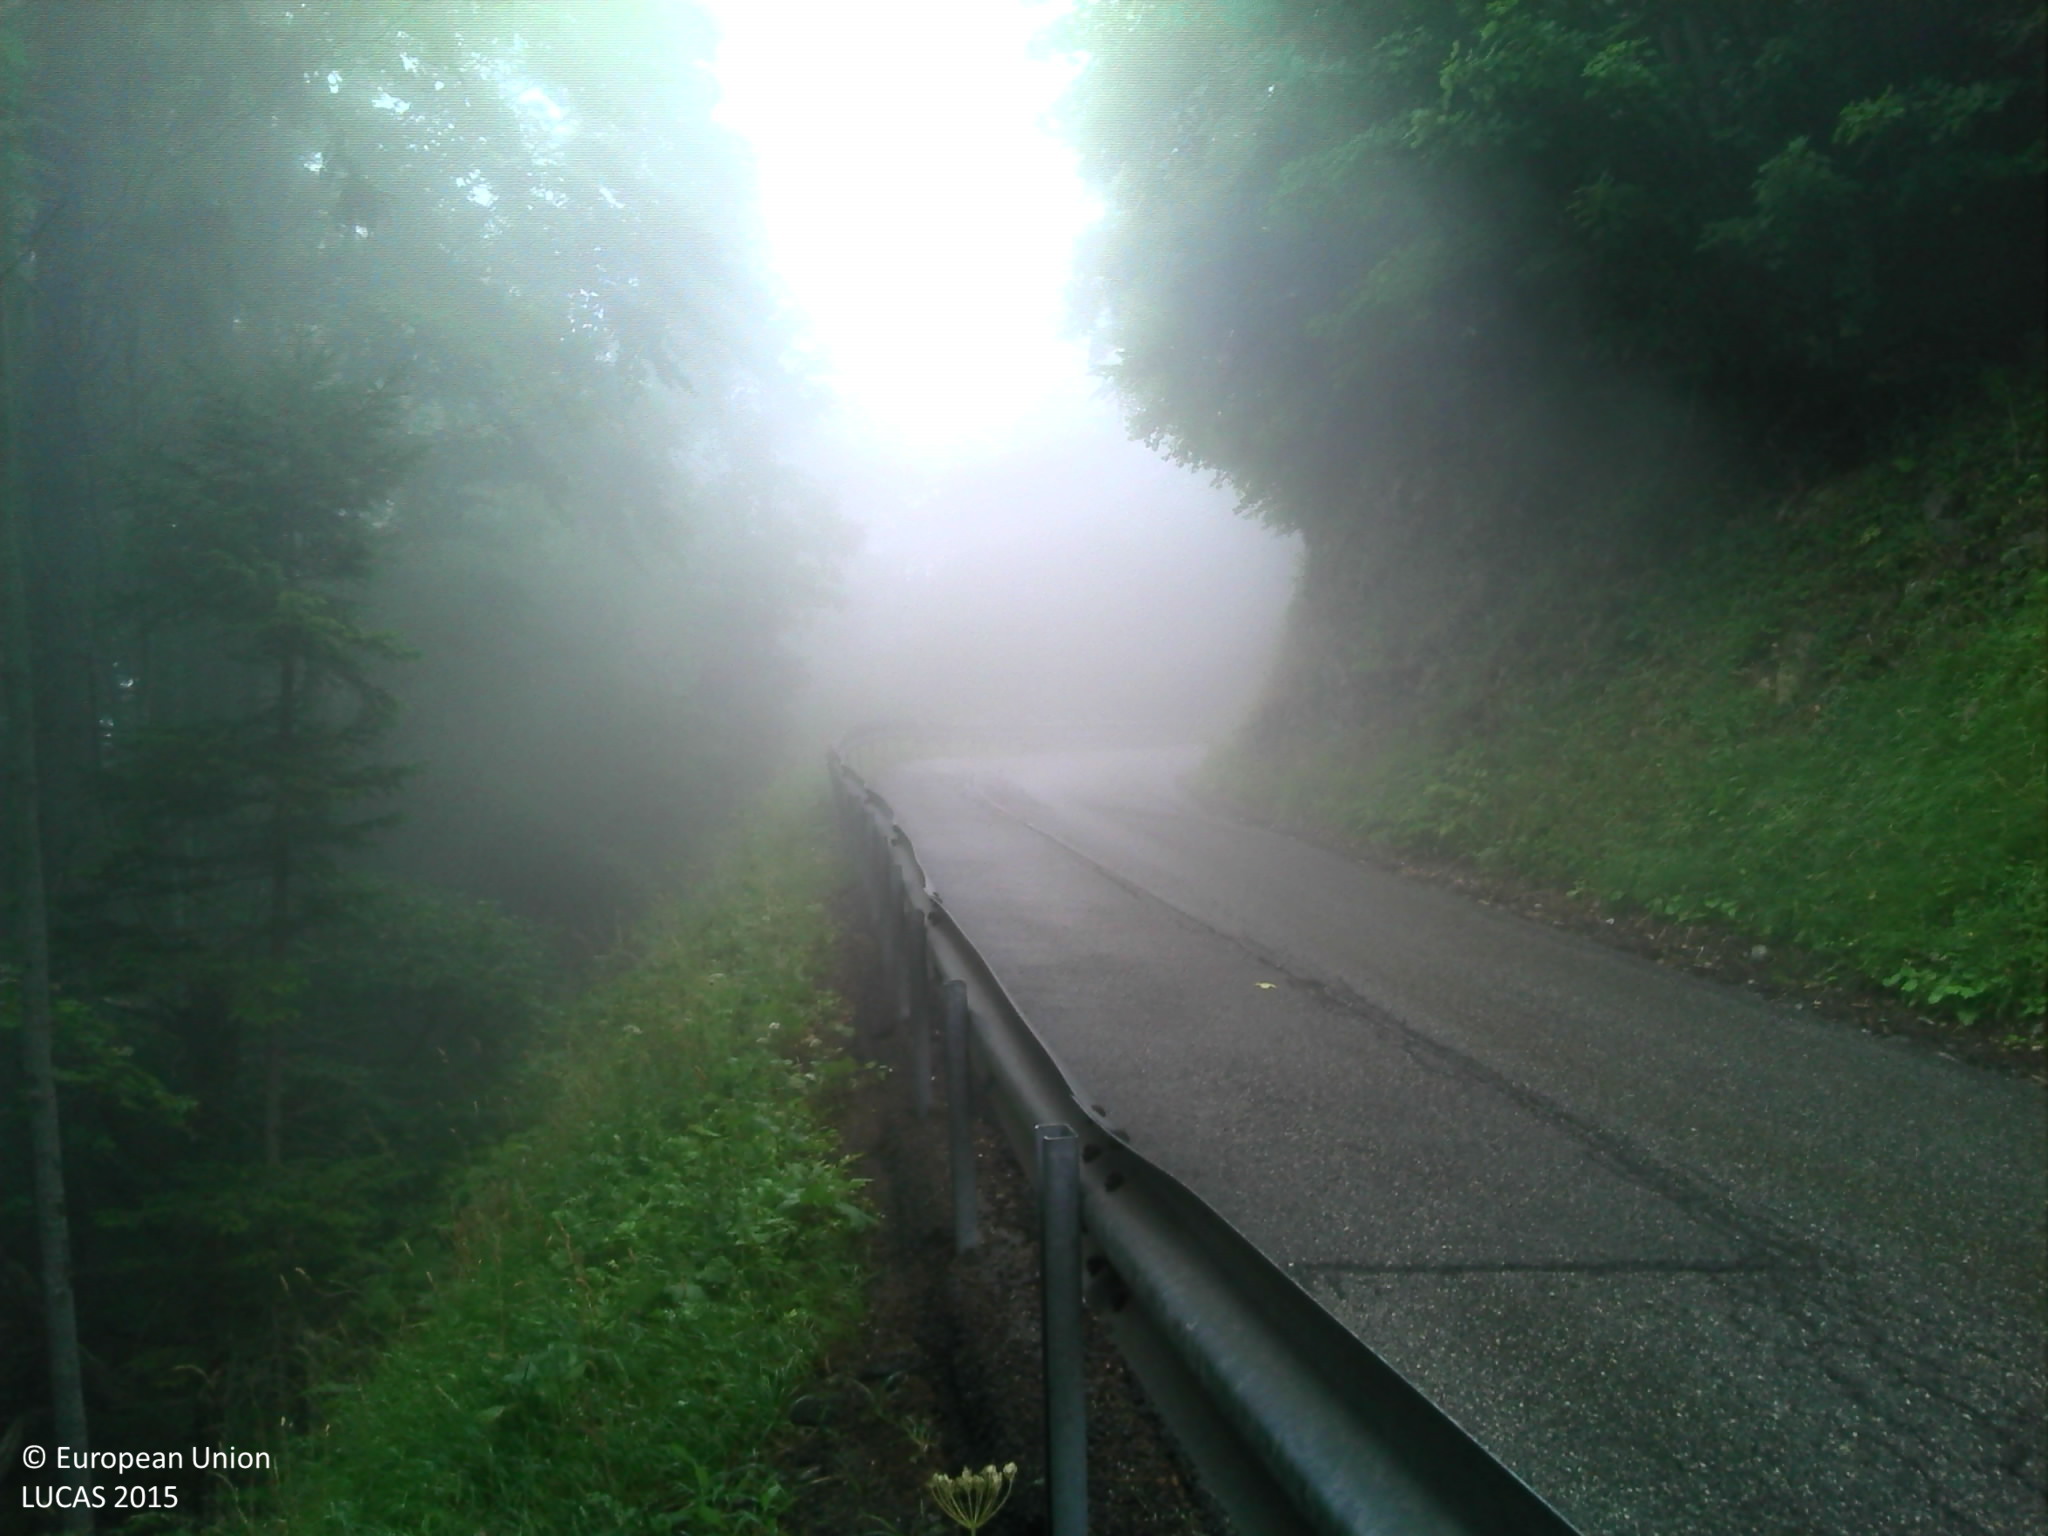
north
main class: Woodland
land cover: Spruce dominated coniferous woodland
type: alpine coniferous forest
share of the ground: > 75 %
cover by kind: coniferous forest trees 70 %, broadleaved forest trees 15 %, herbaceous plants 10 %, lichens and mosses 5 %
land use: Semi-natural and natural areas not in use
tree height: > 5 m
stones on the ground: 25 - 50 %
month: July
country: FR
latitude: 45.9627
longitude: 6.3005
